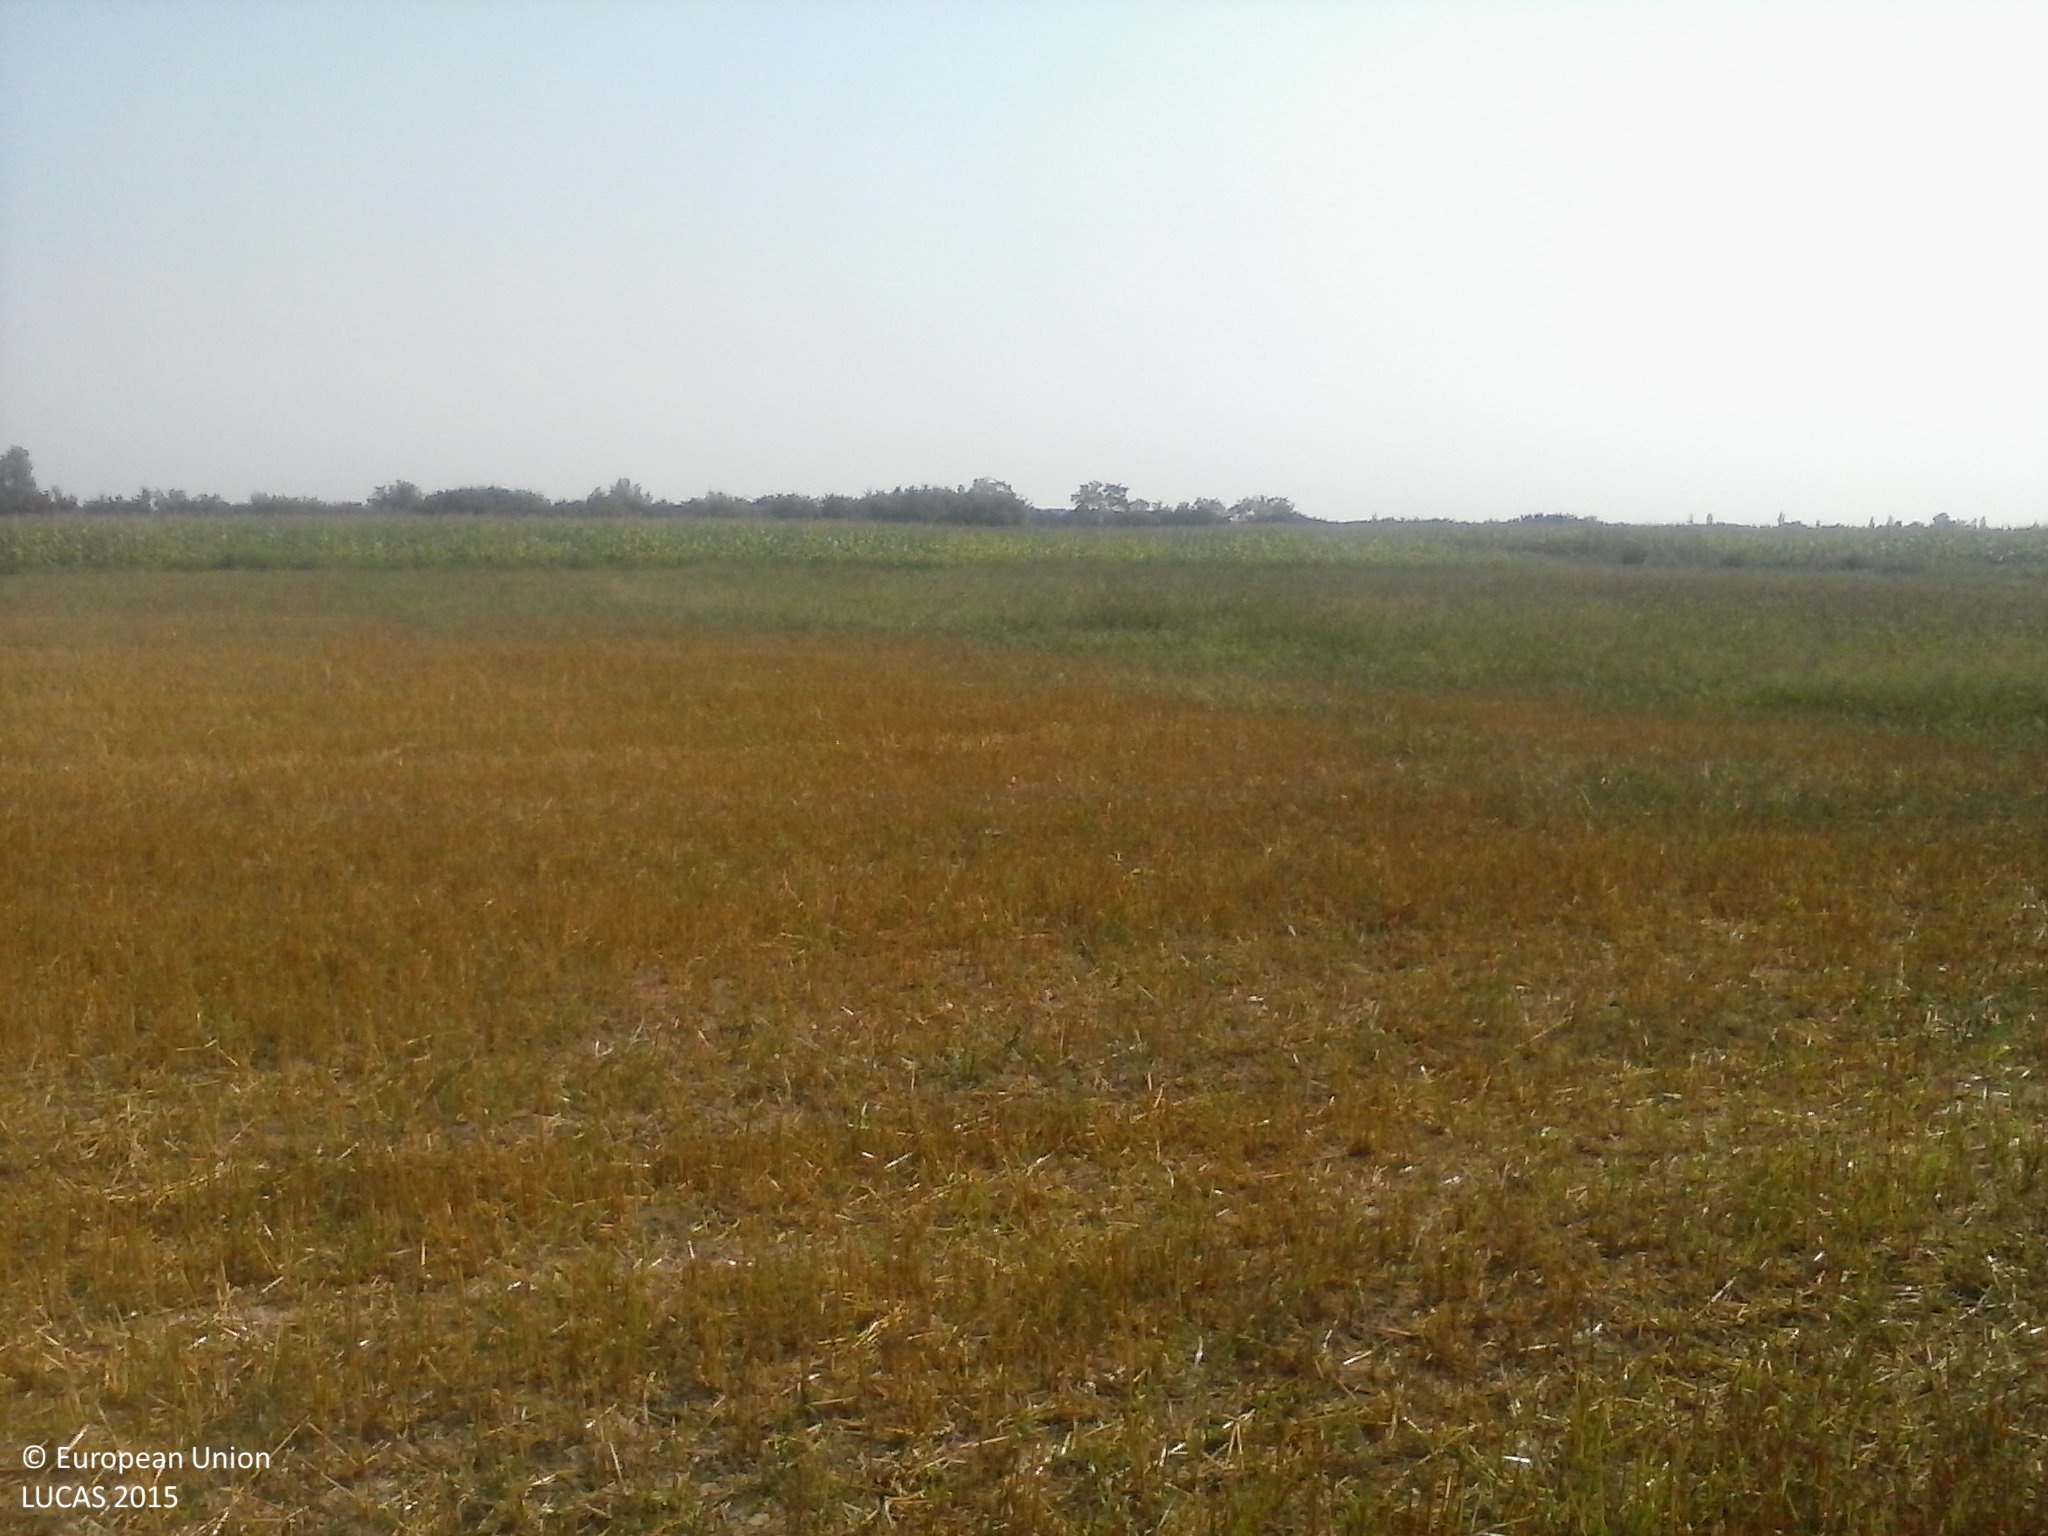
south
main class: Cropland
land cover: Oats
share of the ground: > 75 %
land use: Agriculture (excluding fallow land and kitchen gardens)
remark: Harvested field
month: August
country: HU
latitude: 46.0124
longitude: 17.7926
